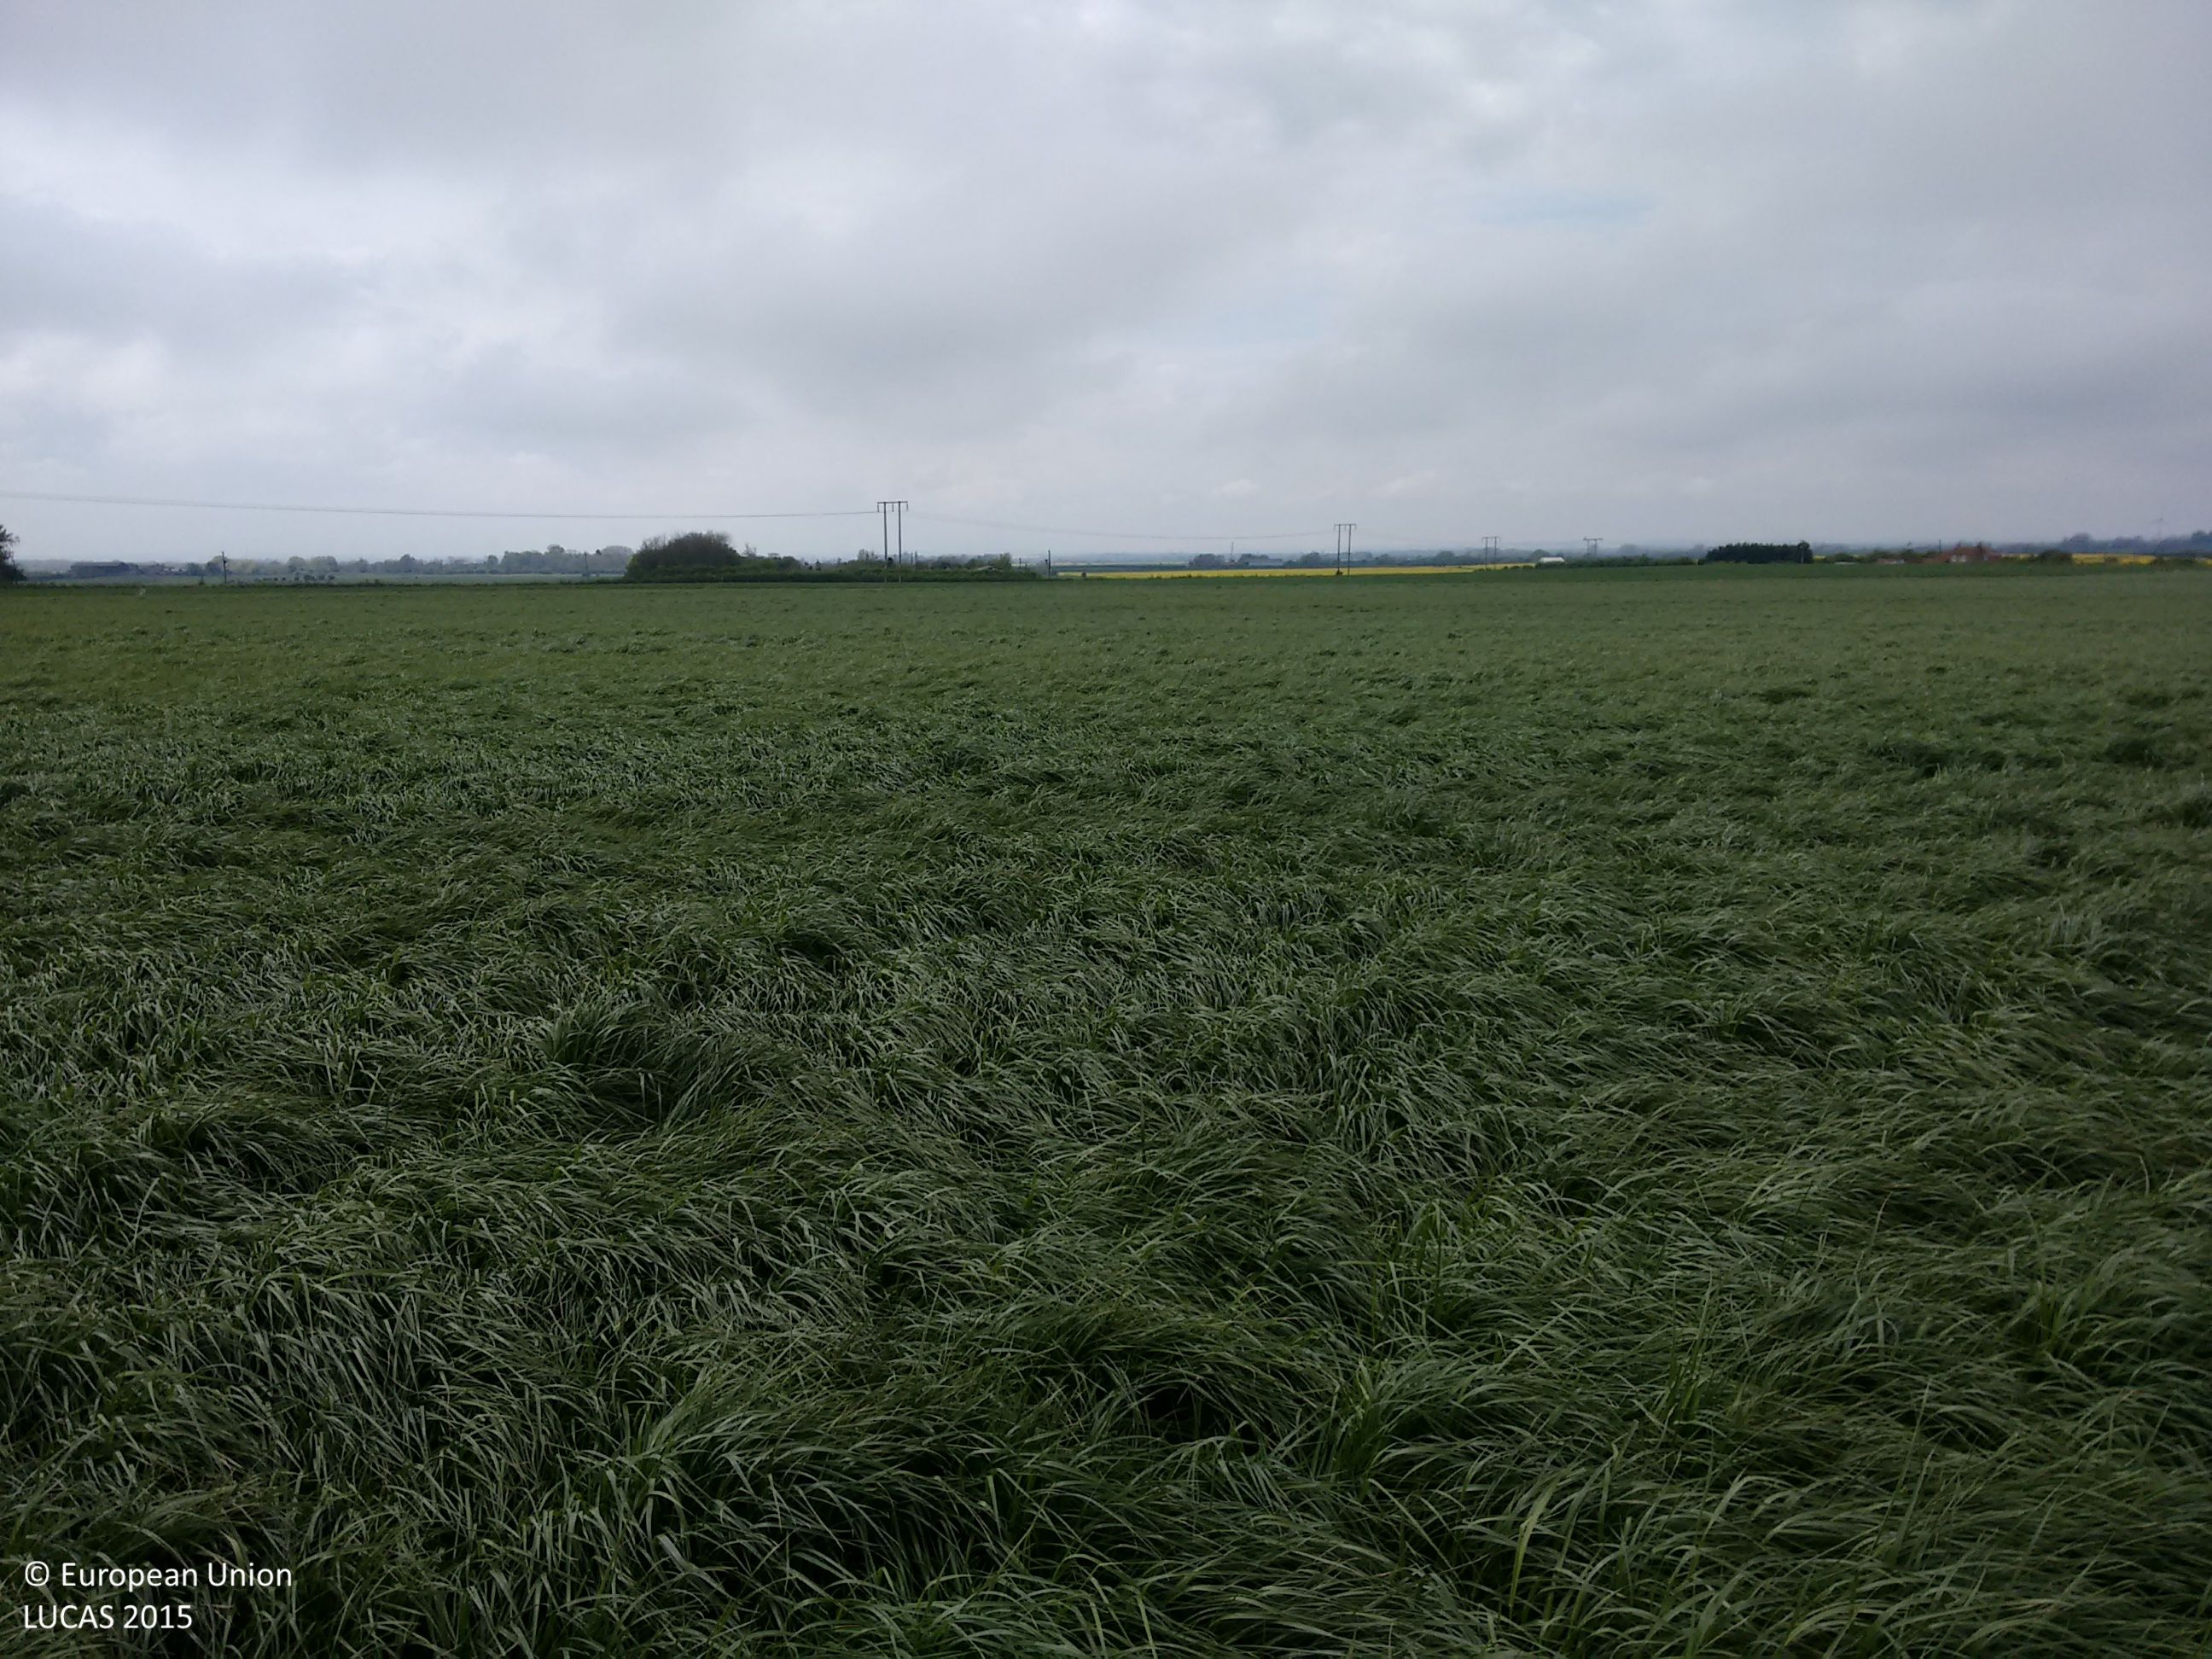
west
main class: Grassland
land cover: Grassland without tree/shrub cover
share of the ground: > 75 %
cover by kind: herbaceous plants 100 %
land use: Agriculture (excluding fallow land and kitchen gardens)
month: May
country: GB
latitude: 53.9569
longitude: -0.3215
